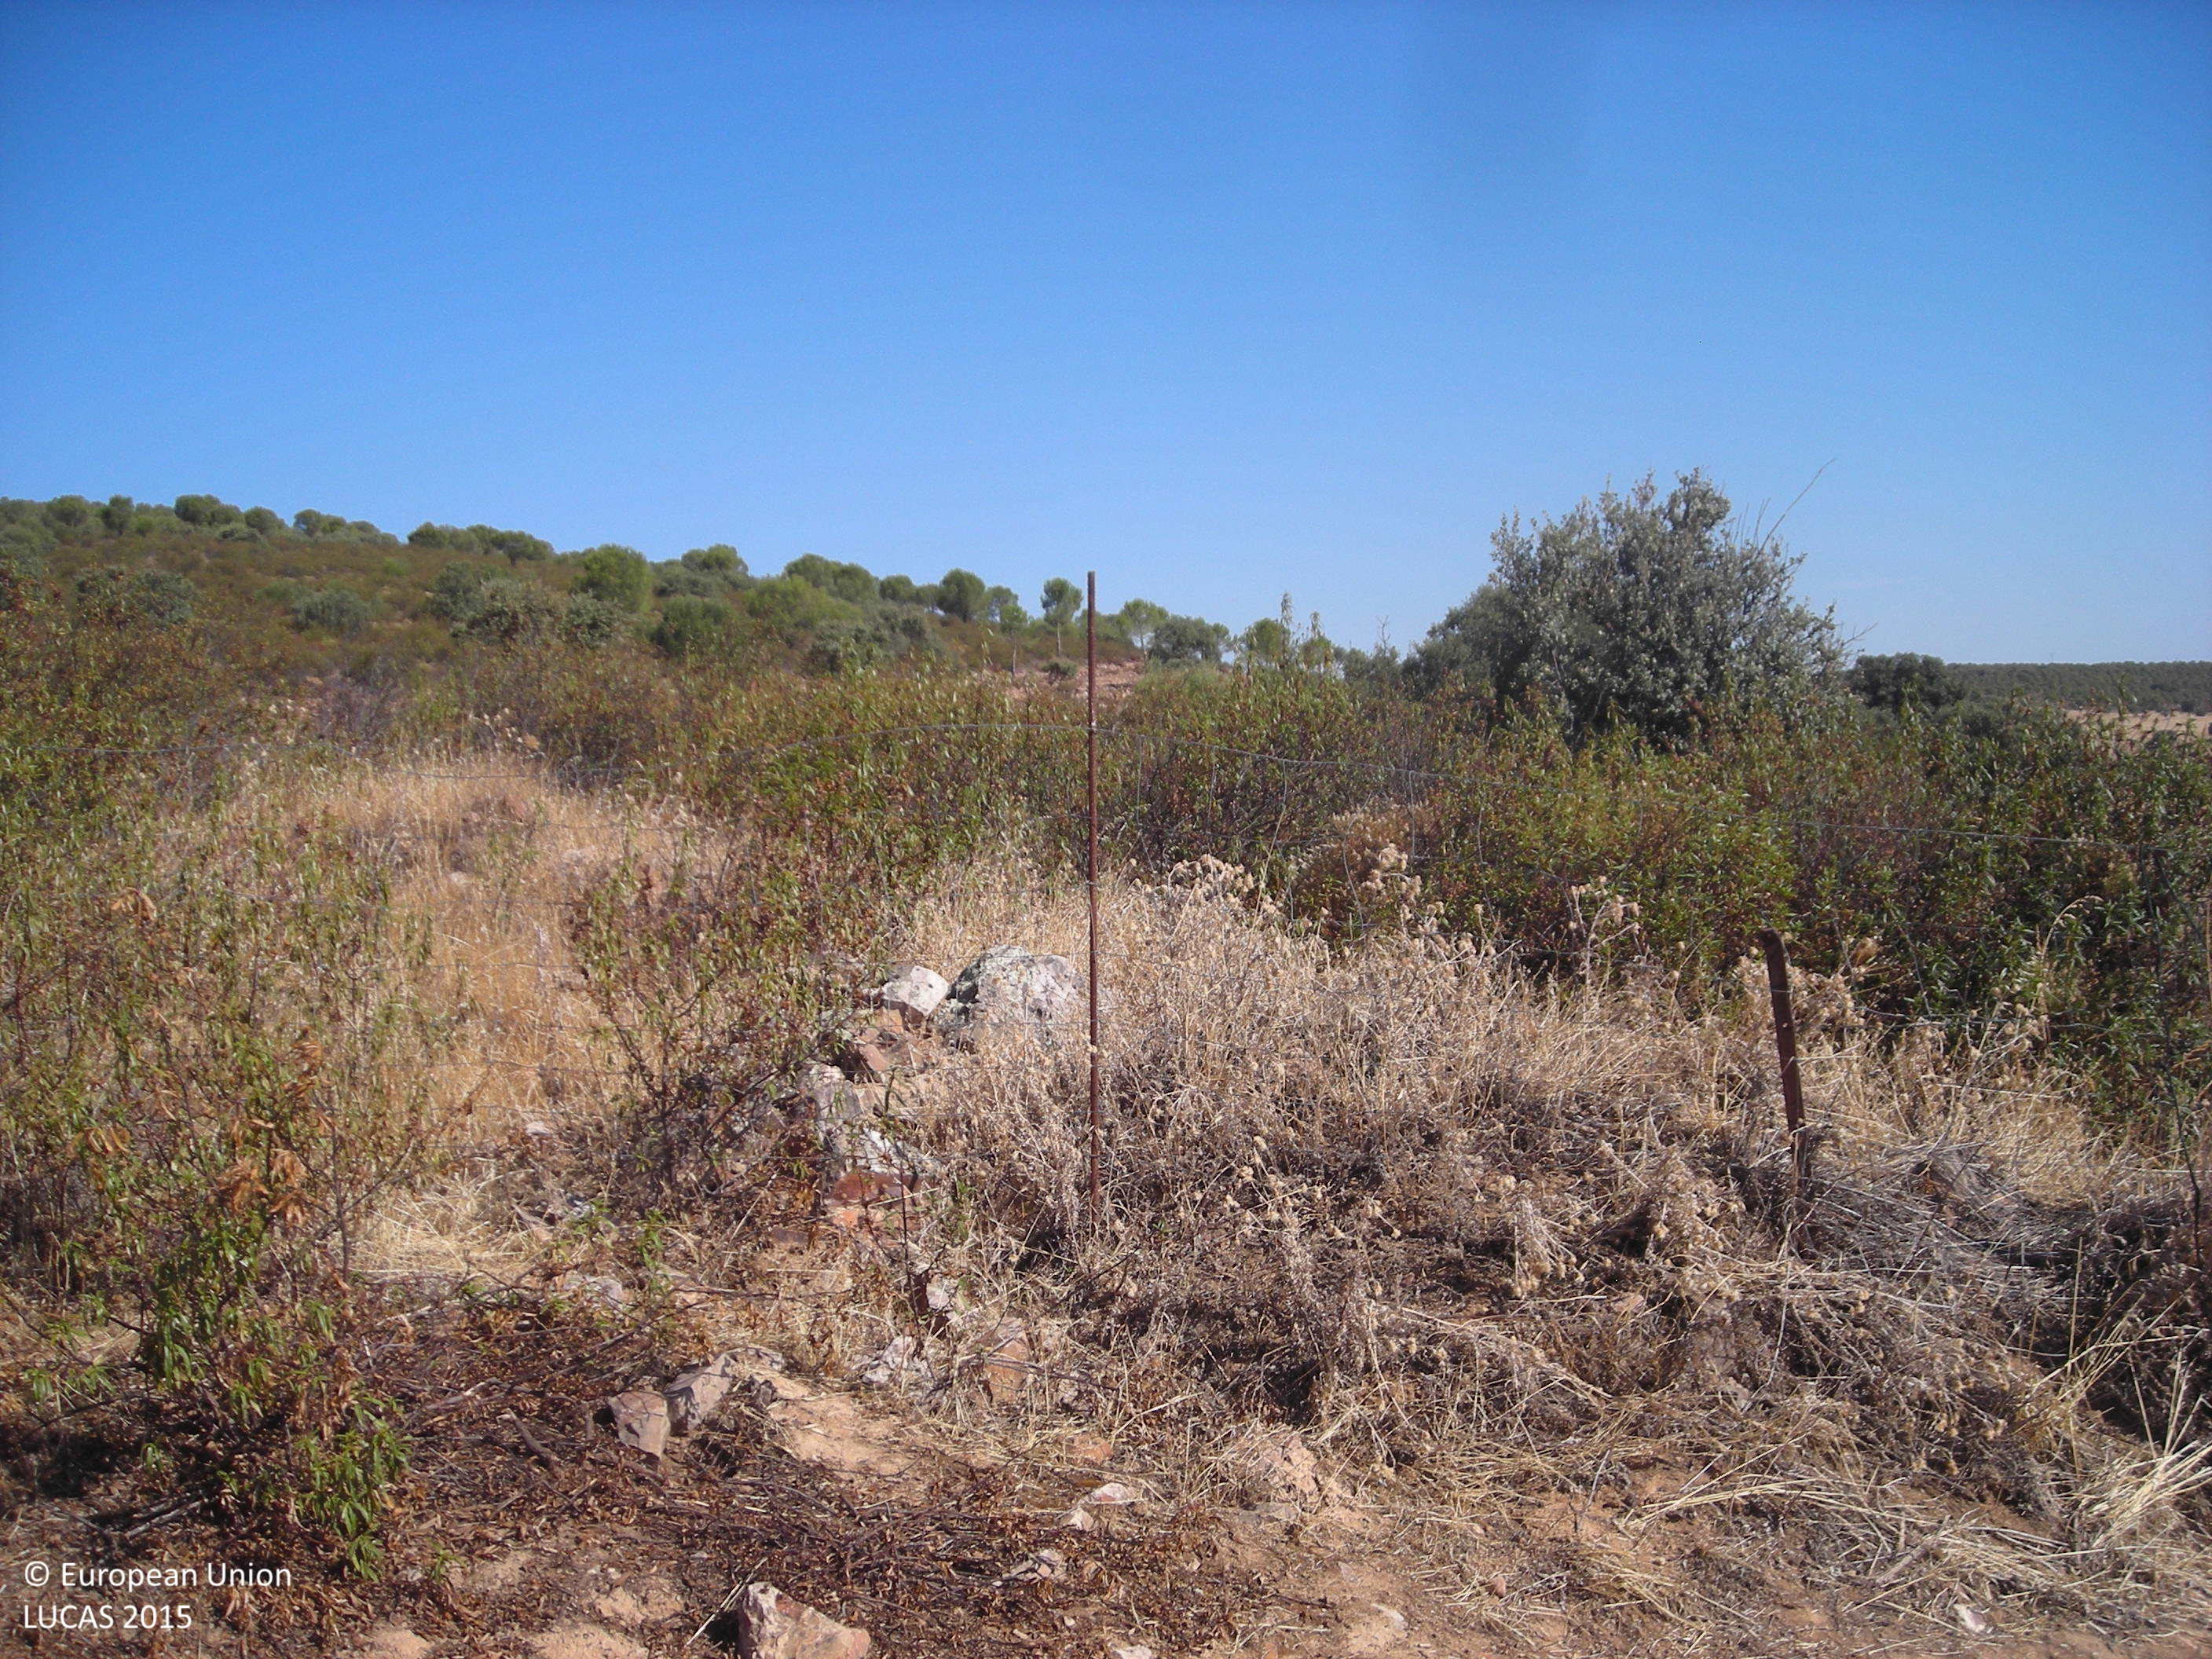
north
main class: Woodland
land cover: Broadleaved woodland
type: broadleaved evergreen forest
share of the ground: 25 - 50 %
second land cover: Grassland without tree/shrub cover
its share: 50 - 75 %
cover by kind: herbaceous plants 60 %, broadleaved forest trees 40 %
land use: Forestry
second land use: Agriculture (excluding fallow land and kitchen gardens)
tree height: > 5 m
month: July
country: ES
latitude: 38.8598
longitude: -5.8468
